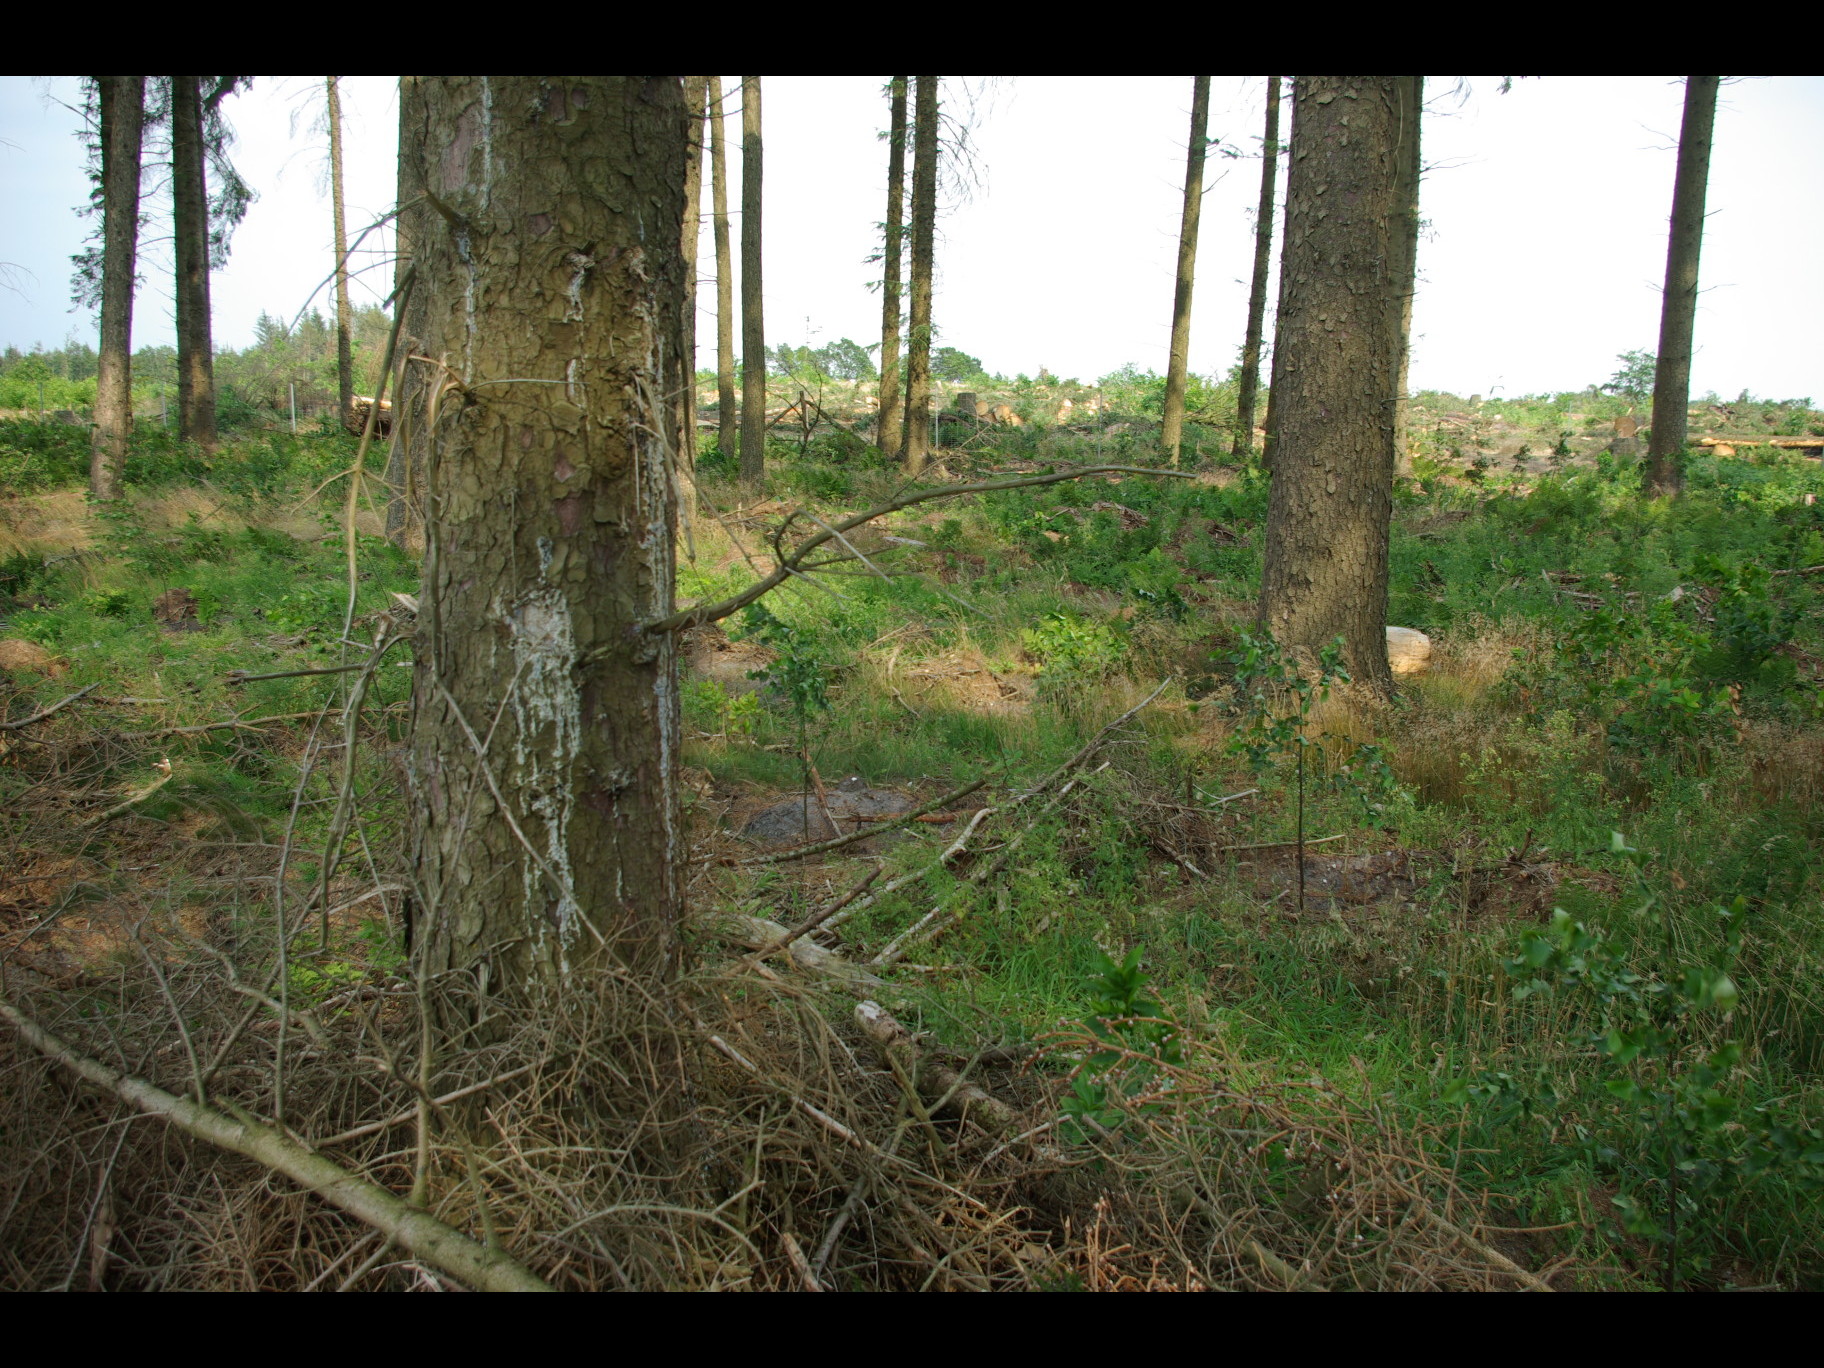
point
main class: Woodland
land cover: Spruce dominated coniferous woodland
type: hemiboreal forest and nemoral coniferous forest and mixed broadleaved-coniferous forest
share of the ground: 50 - 75 %
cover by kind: coniferous forest trees 60 %, herbaceous plants 30 %, unconsolidated bare surface 10 %
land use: Forestry
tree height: > 5 m
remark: Clear cut
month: August
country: DE
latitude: 54.5502
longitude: 9.3048
